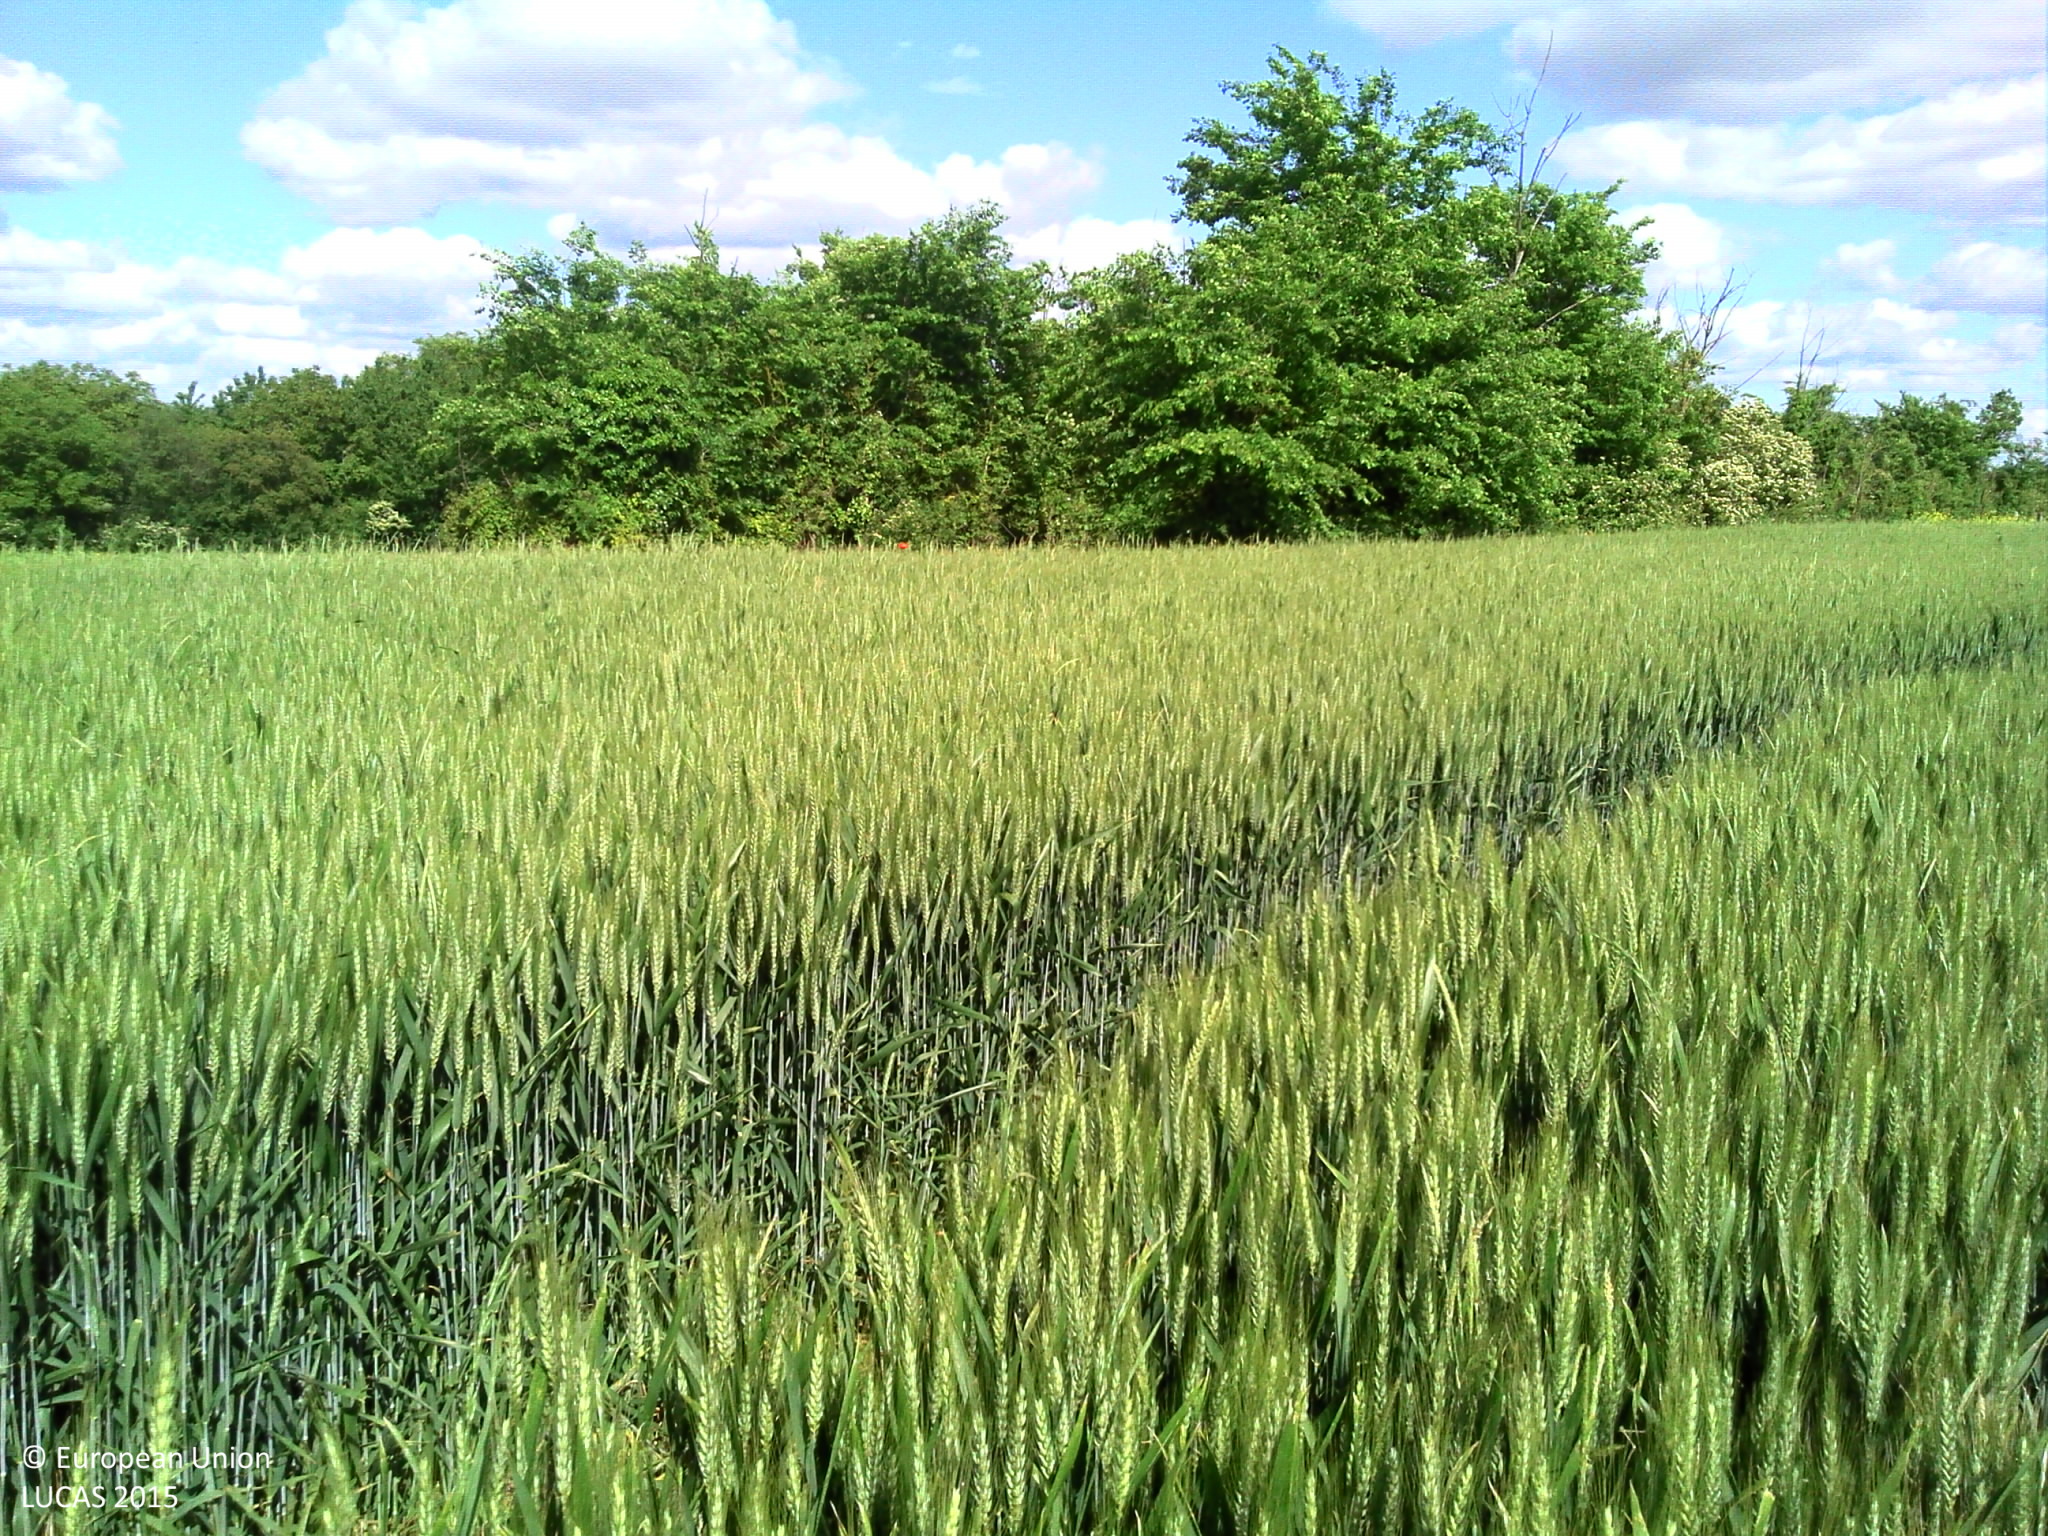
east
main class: Cropland
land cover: Common wheat
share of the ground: > 75 %
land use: Agriculture (excluding fallow land and kitchen gardens)
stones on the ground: < 10 %
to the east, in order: Common wheat; Grass margins; Managed hedges; Ditches and canals; Grass margins; Paved roads, cycling and walking lanes; Grass margins; Managed hedges; Triticale; Grass margins; Broadleaved woodland; Grass margins; Sunflower; Maize
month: May
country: FR
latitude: 46.7704
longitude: 0.1967
